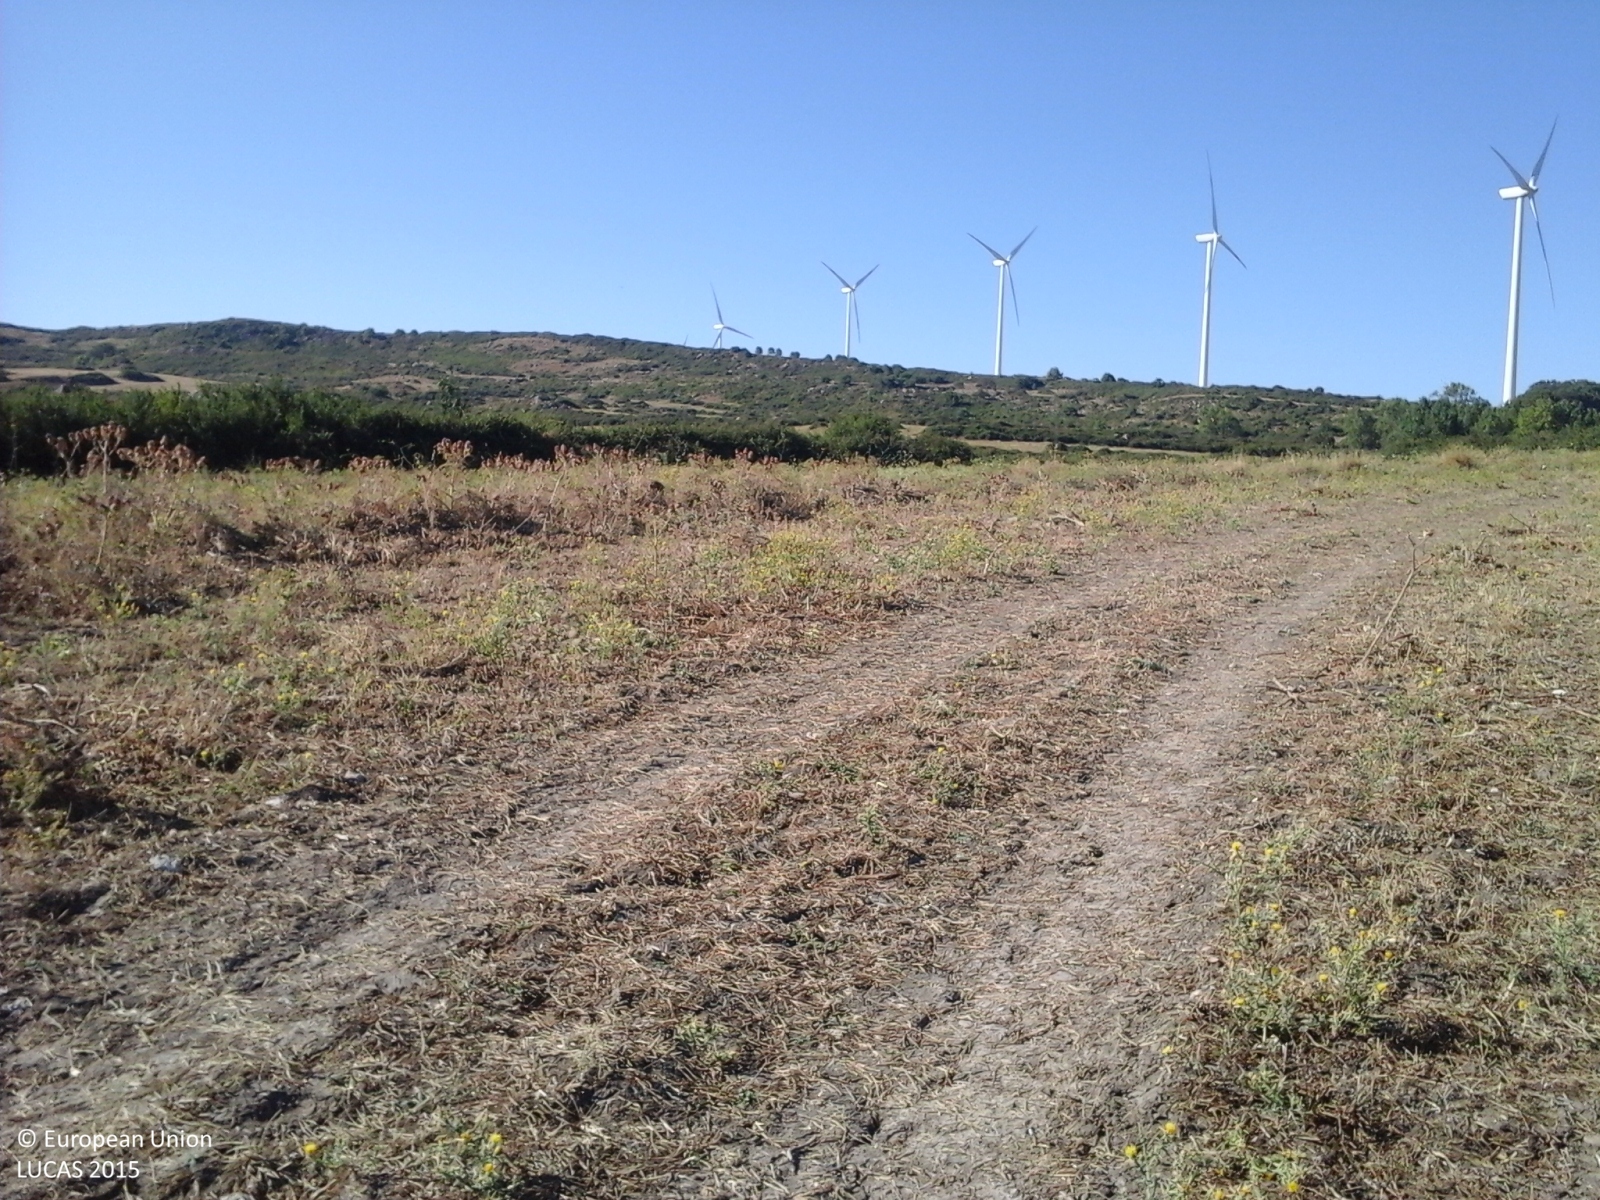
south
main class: Cropland
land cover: Mixed cereals for fodder
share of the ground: > 75 %
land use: Agriculture (excluding fallow land and kitchen gardens)
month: July
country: IT
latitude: 37.1175
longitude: 14.7912
